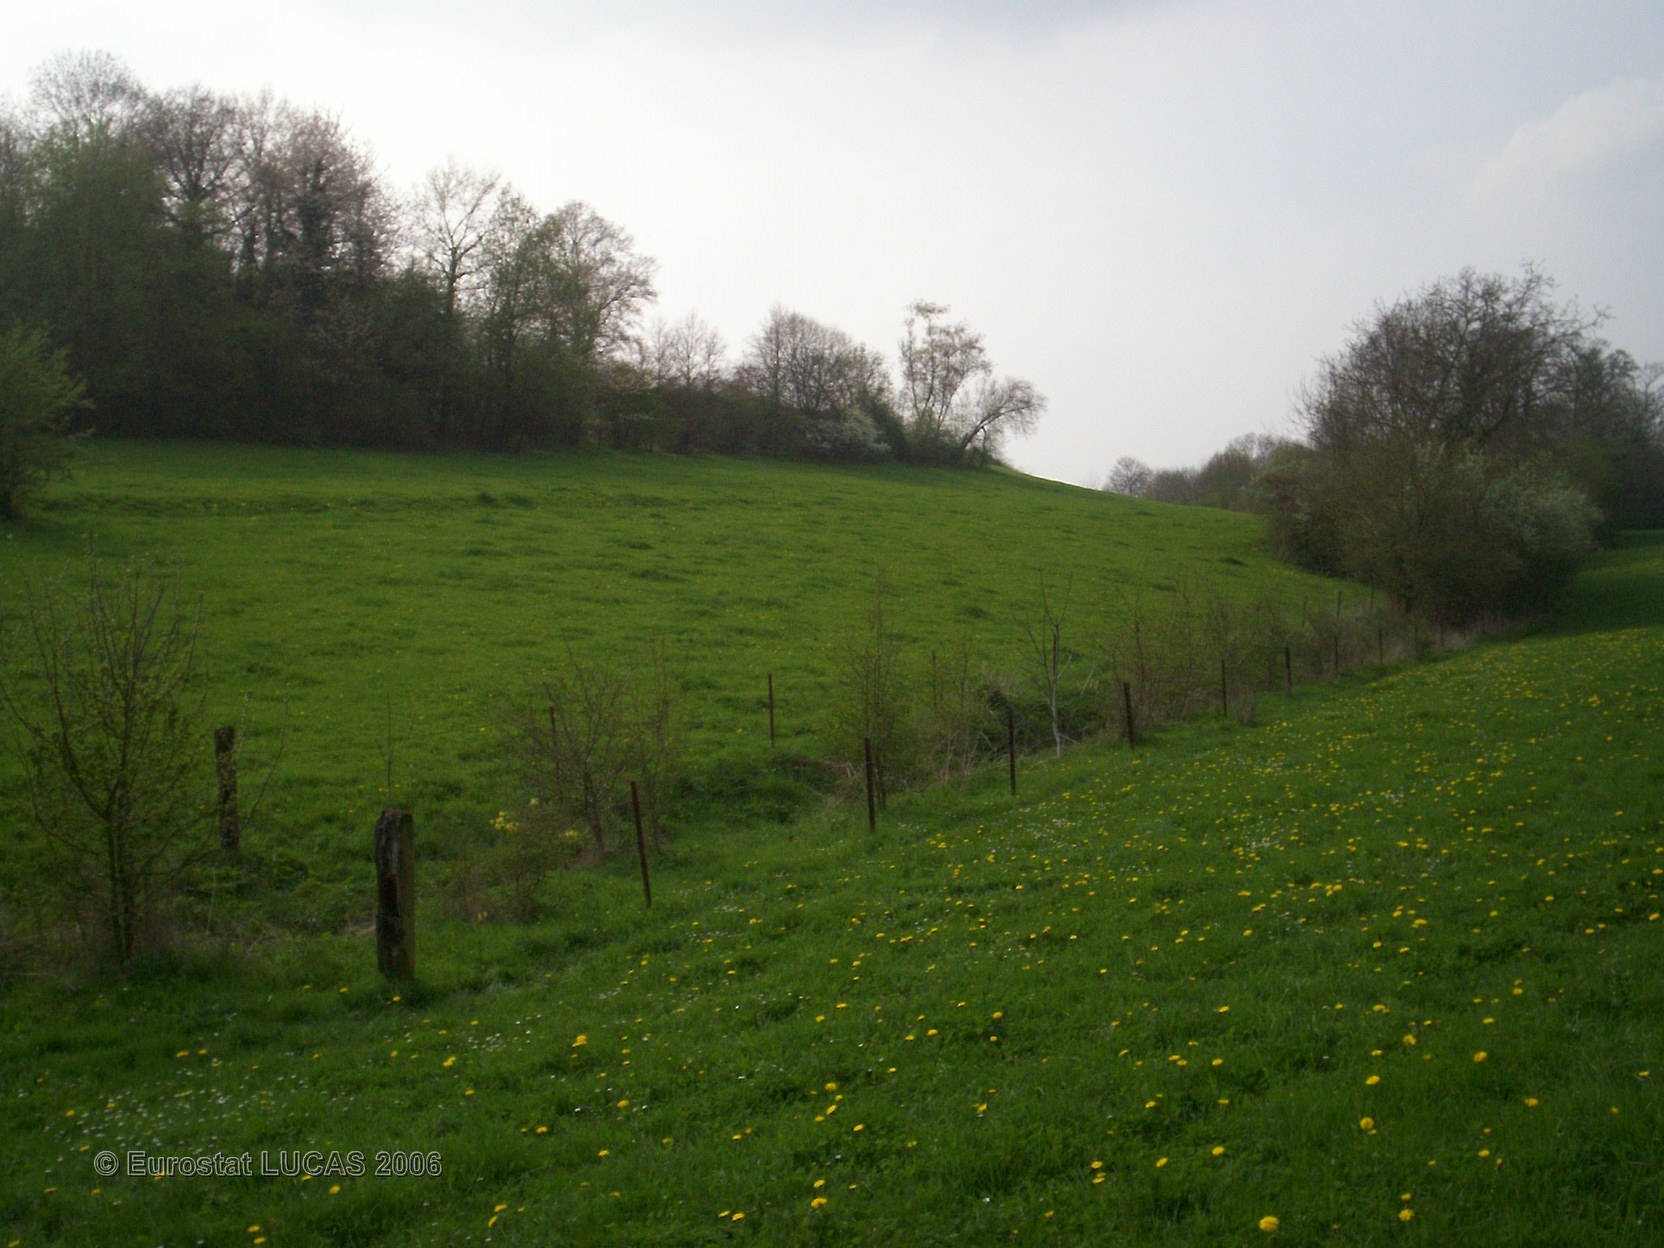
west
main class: Grassland
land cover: Grassland without tree/shrub cover
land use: Agriculture (excluding fallow land and kitchen gardens)
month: April
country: FR
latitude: 49.5679
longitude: 4.5623
